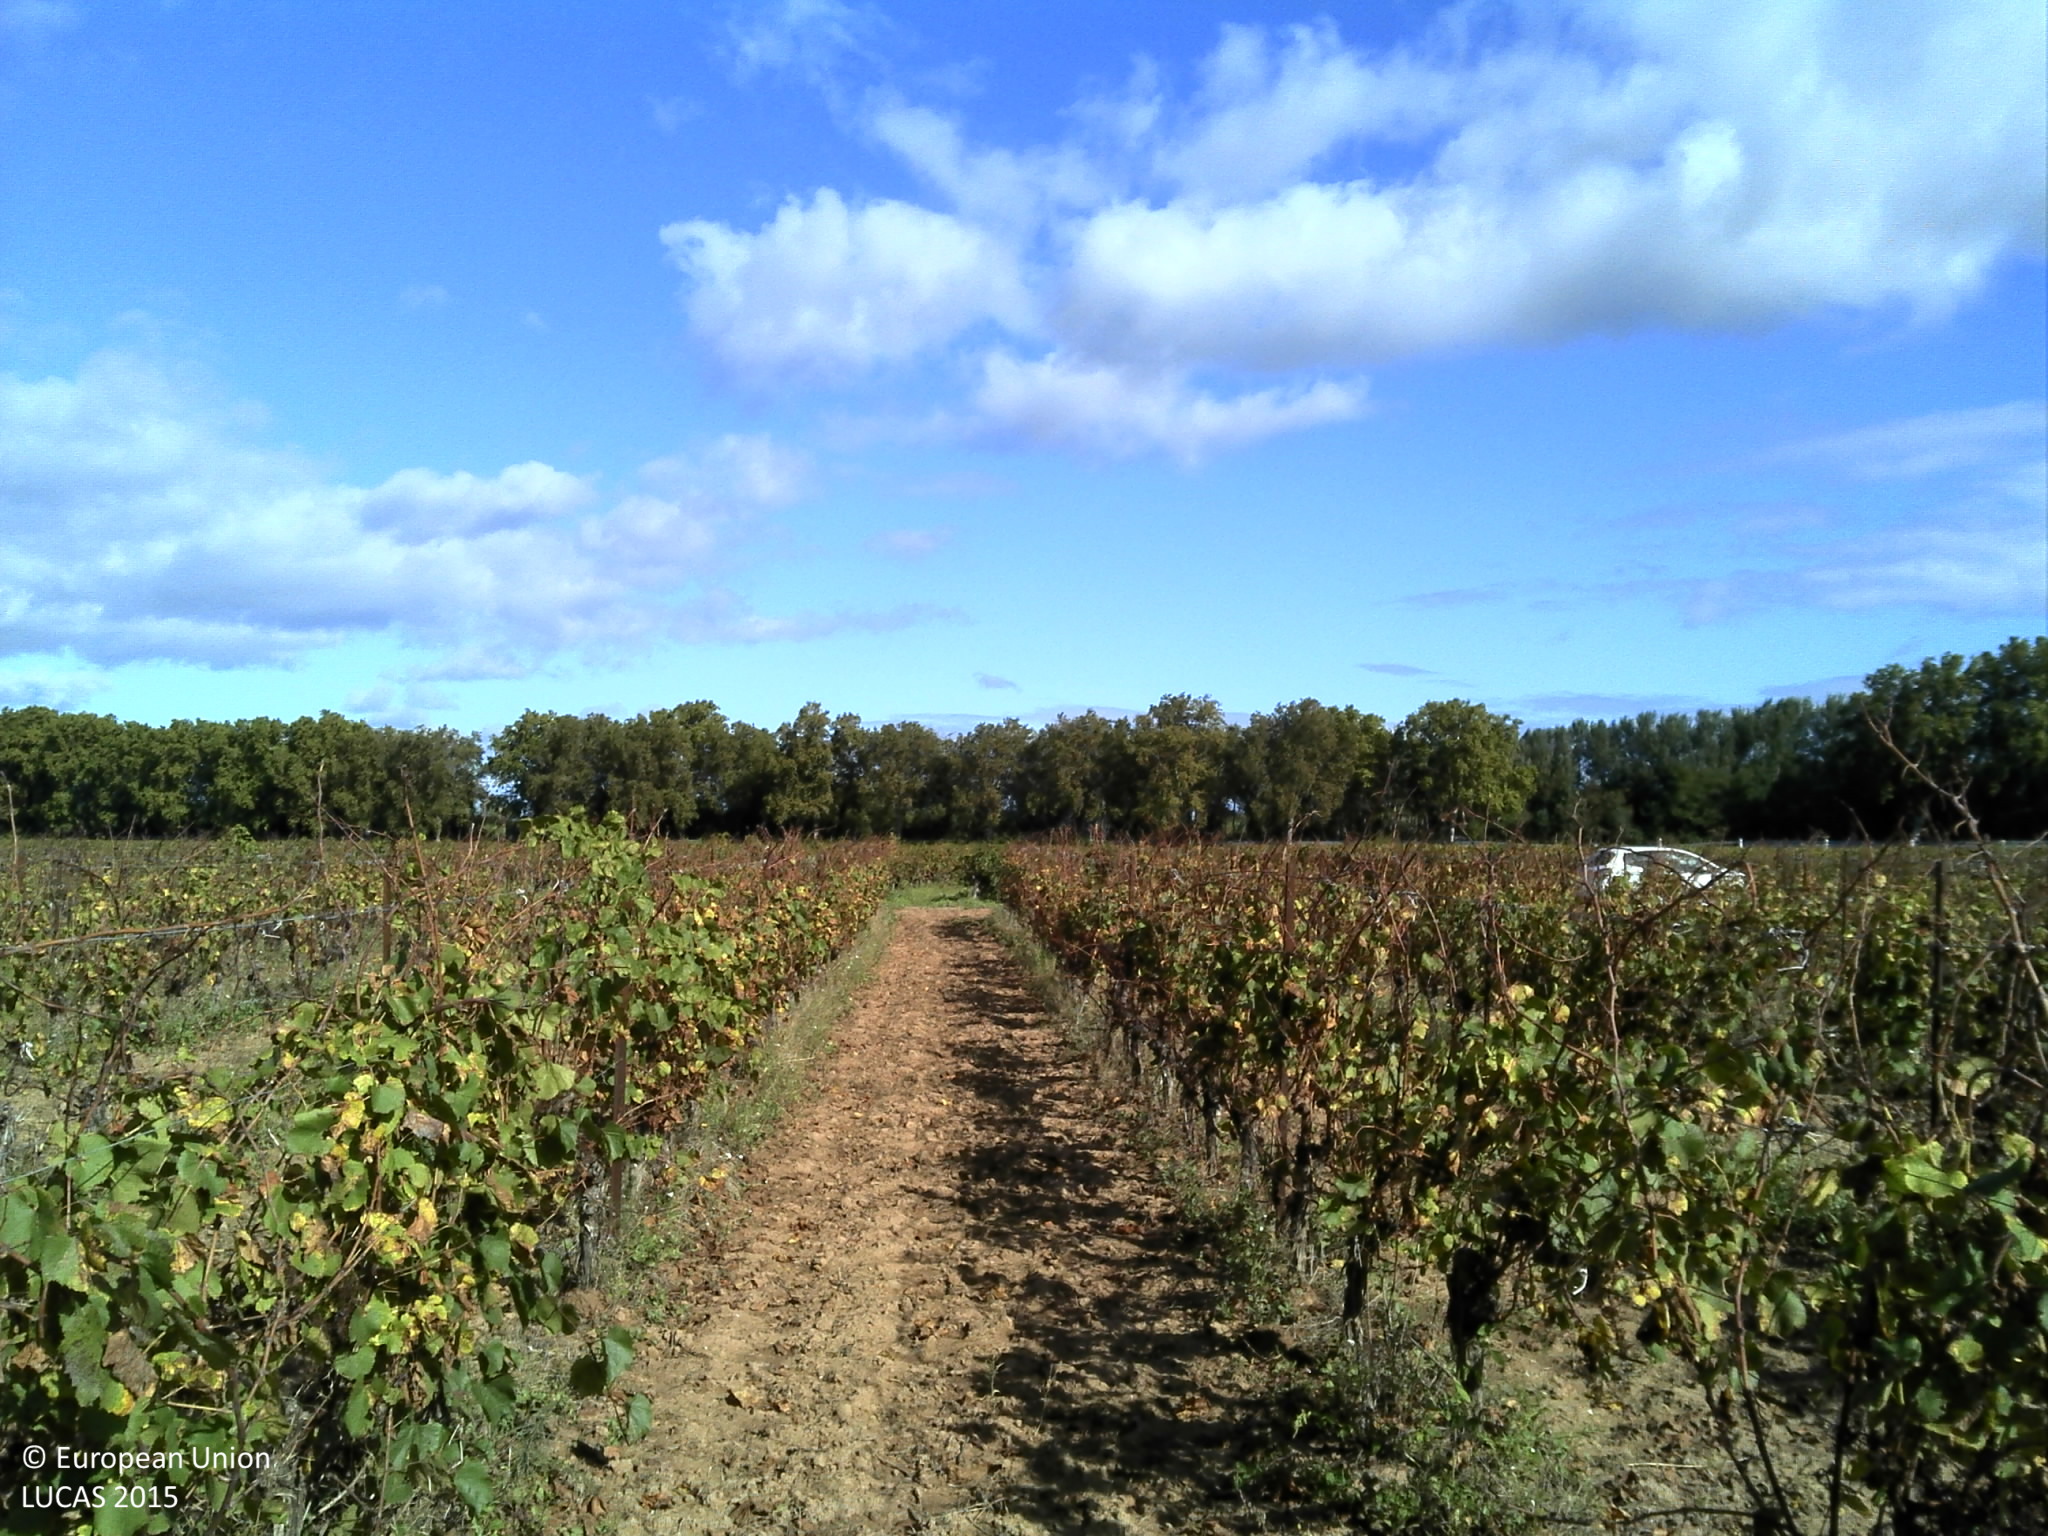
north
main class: Cropland
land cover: Vineyards
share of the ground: 10 - 25 %
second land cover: Other bare soil
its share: > 75 %
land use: Agriculture (excluding fallow land and kitchen gardens)
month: October
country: FR
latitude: 43.3463
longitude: 3.4345
